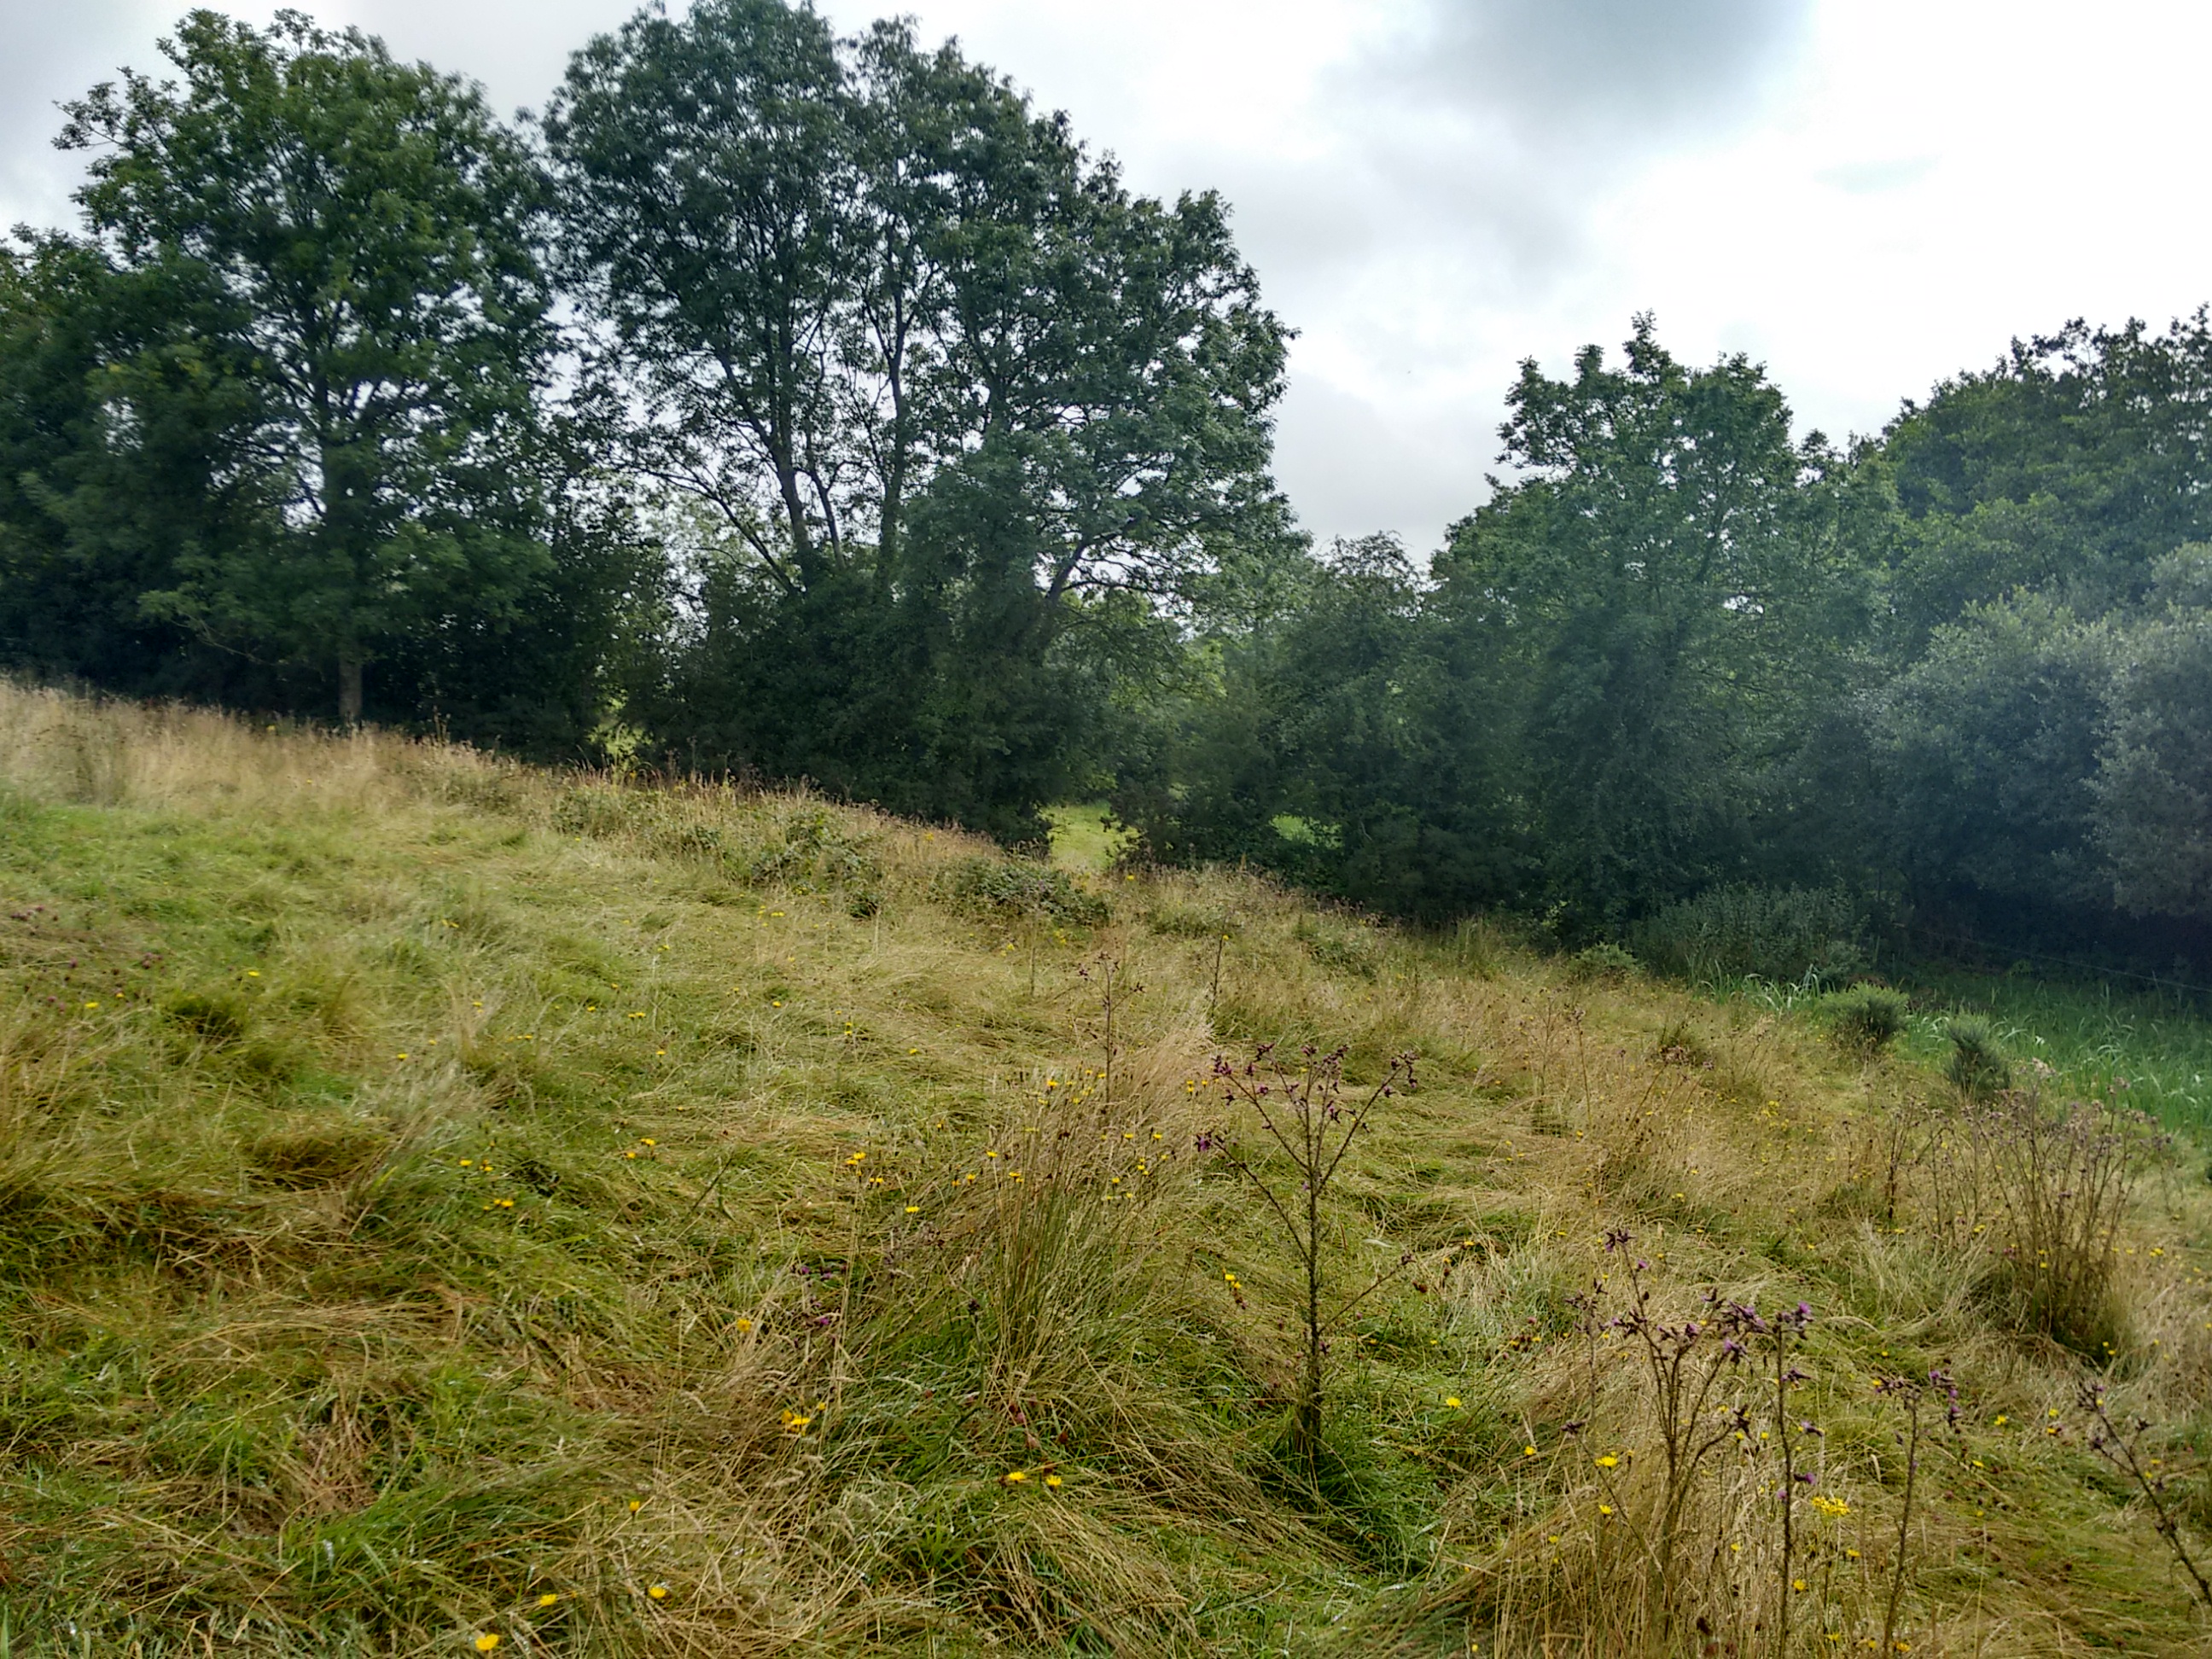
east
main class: Grassland
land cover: Grassland without tree/shrub cover
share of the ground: > 75 %
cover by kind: herbaceous plants 100 %
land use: Agriculture (excluding fallow land and kitchen gardens)
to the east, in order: Grassland without tree/shrub cover; Abandoned hedges; Fences; Grassland without tree/shrub cover; Broadleaved woodland; Rivers and streams; Fences; Grassland without tree/shrub cover; Fences; Electric lines; Broadleaved woodland; Fences; Grassland without tree/shrub cover
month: August
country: GB
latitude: 54.3719
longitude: -6.7730
